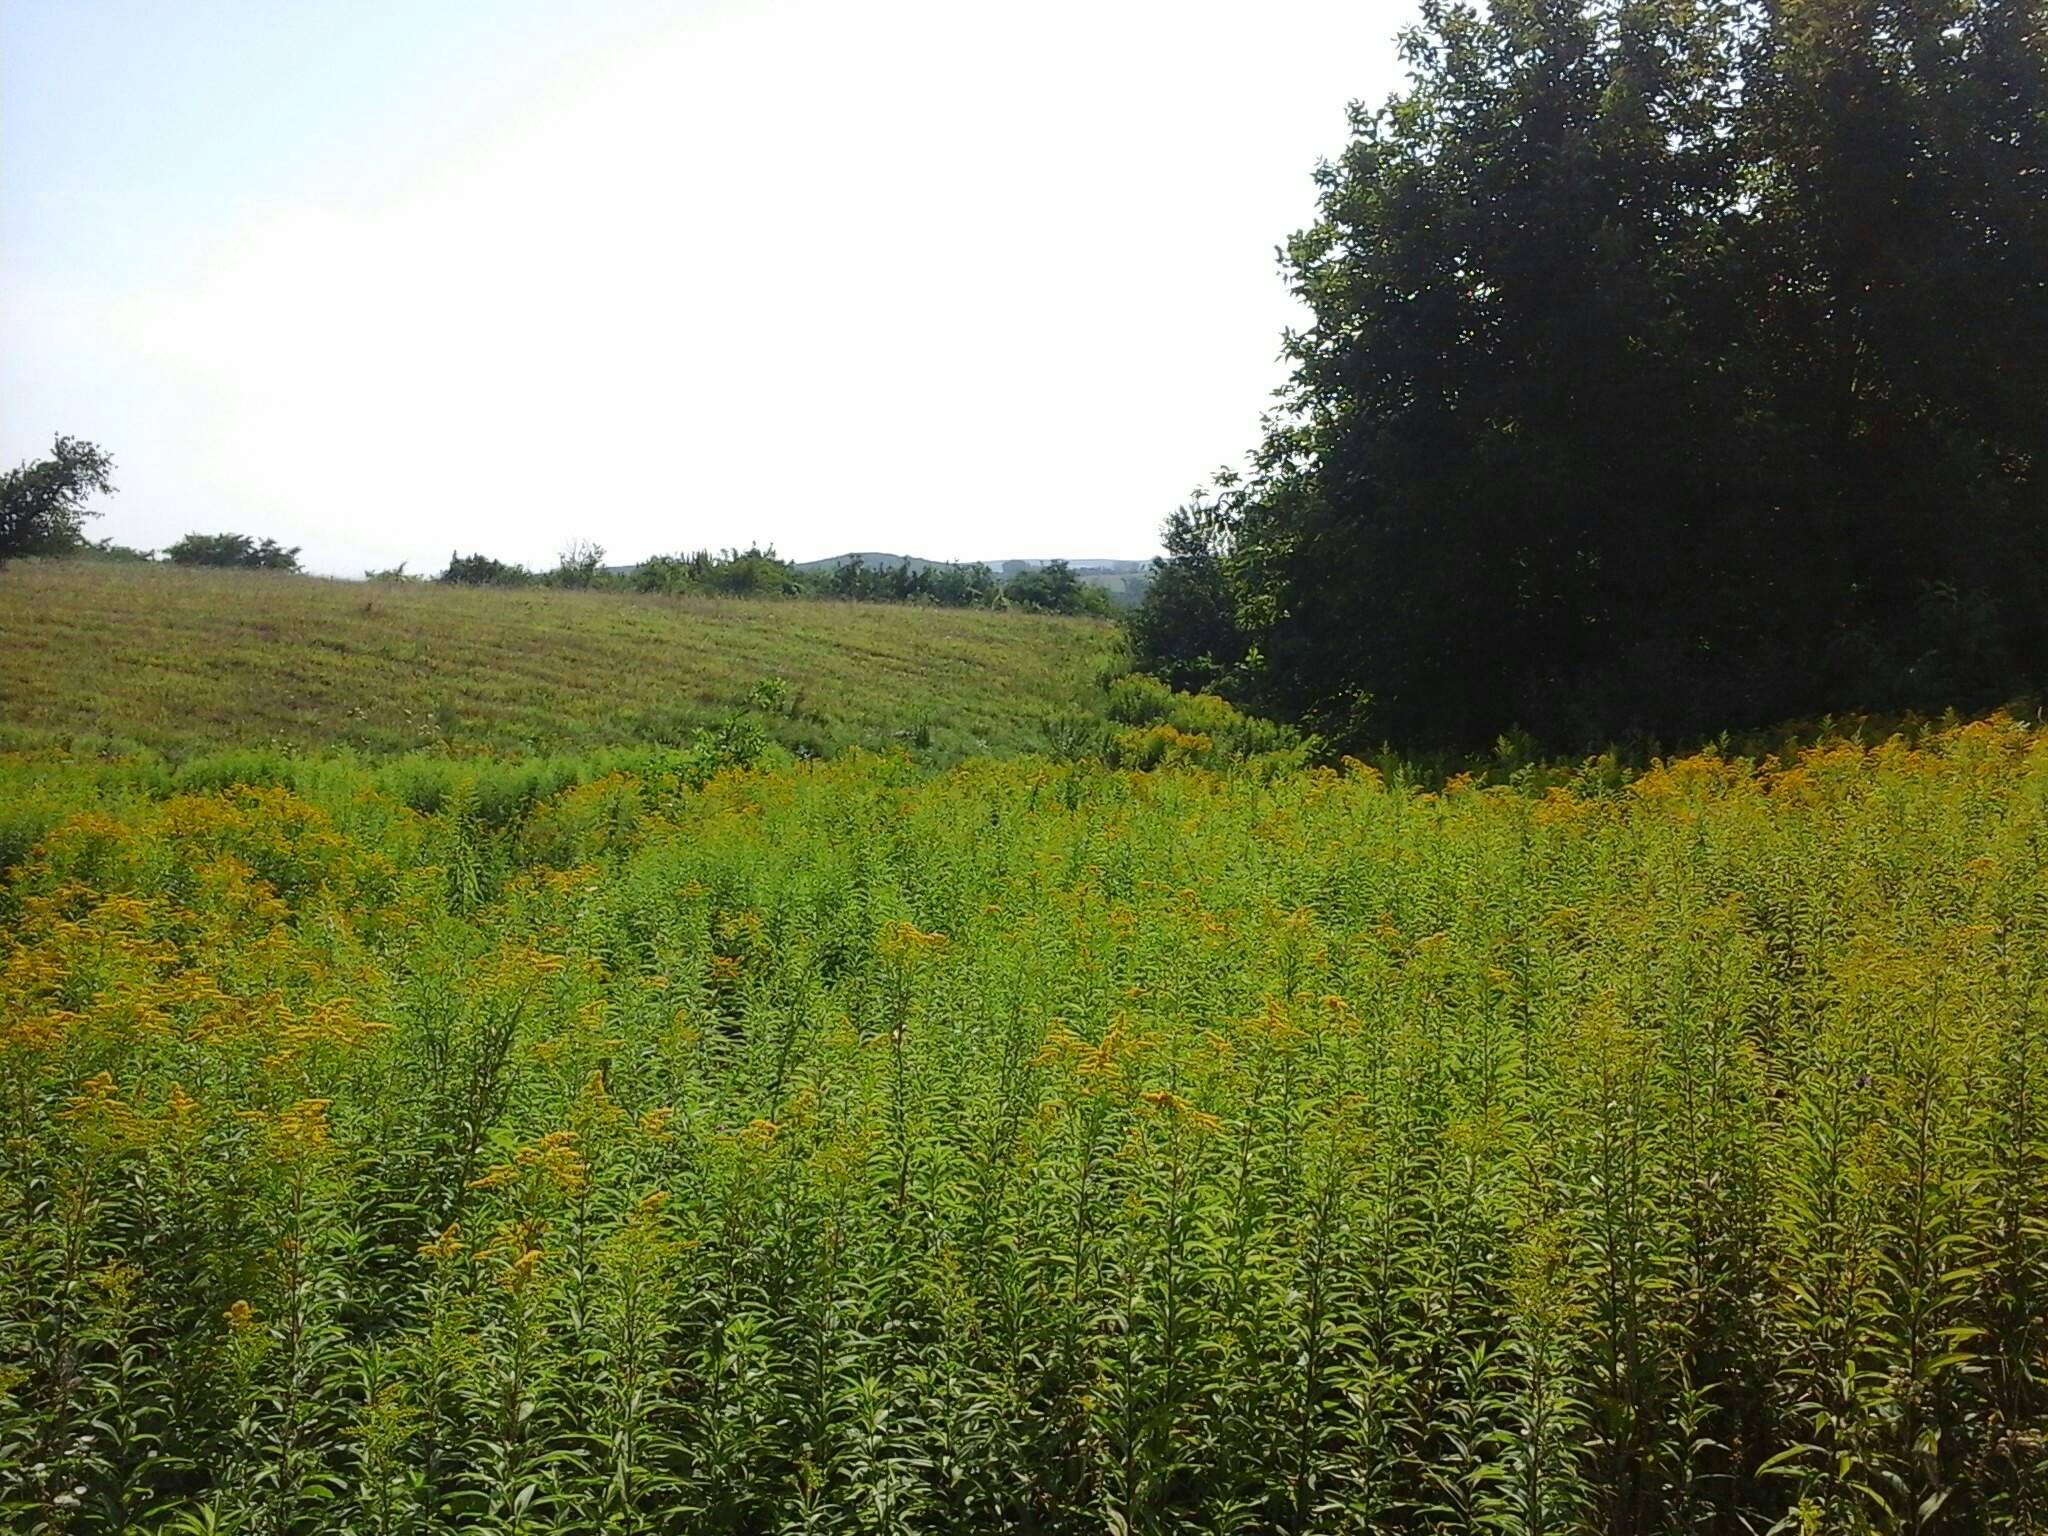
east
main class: Grassland
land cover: Grassland without tree/shrub cover
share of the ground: > 75 %
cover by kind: herbaceous plants 95 %, shrubs 5 %
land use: Agriculture (excluding fallow land and kitchen gardens)
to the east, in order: Grassland without tree/shrub cover; Electric lines; Grassland without tree/shrub cover; Grassland with sparse tree/shrub cover; Broadleaved woodland; Tracks; Broadleaved woodland; Ditches and canals; Broadleaved woodland; Grass margins; Maize
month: August
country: HU
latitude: 47.4515
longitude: 17.9015
